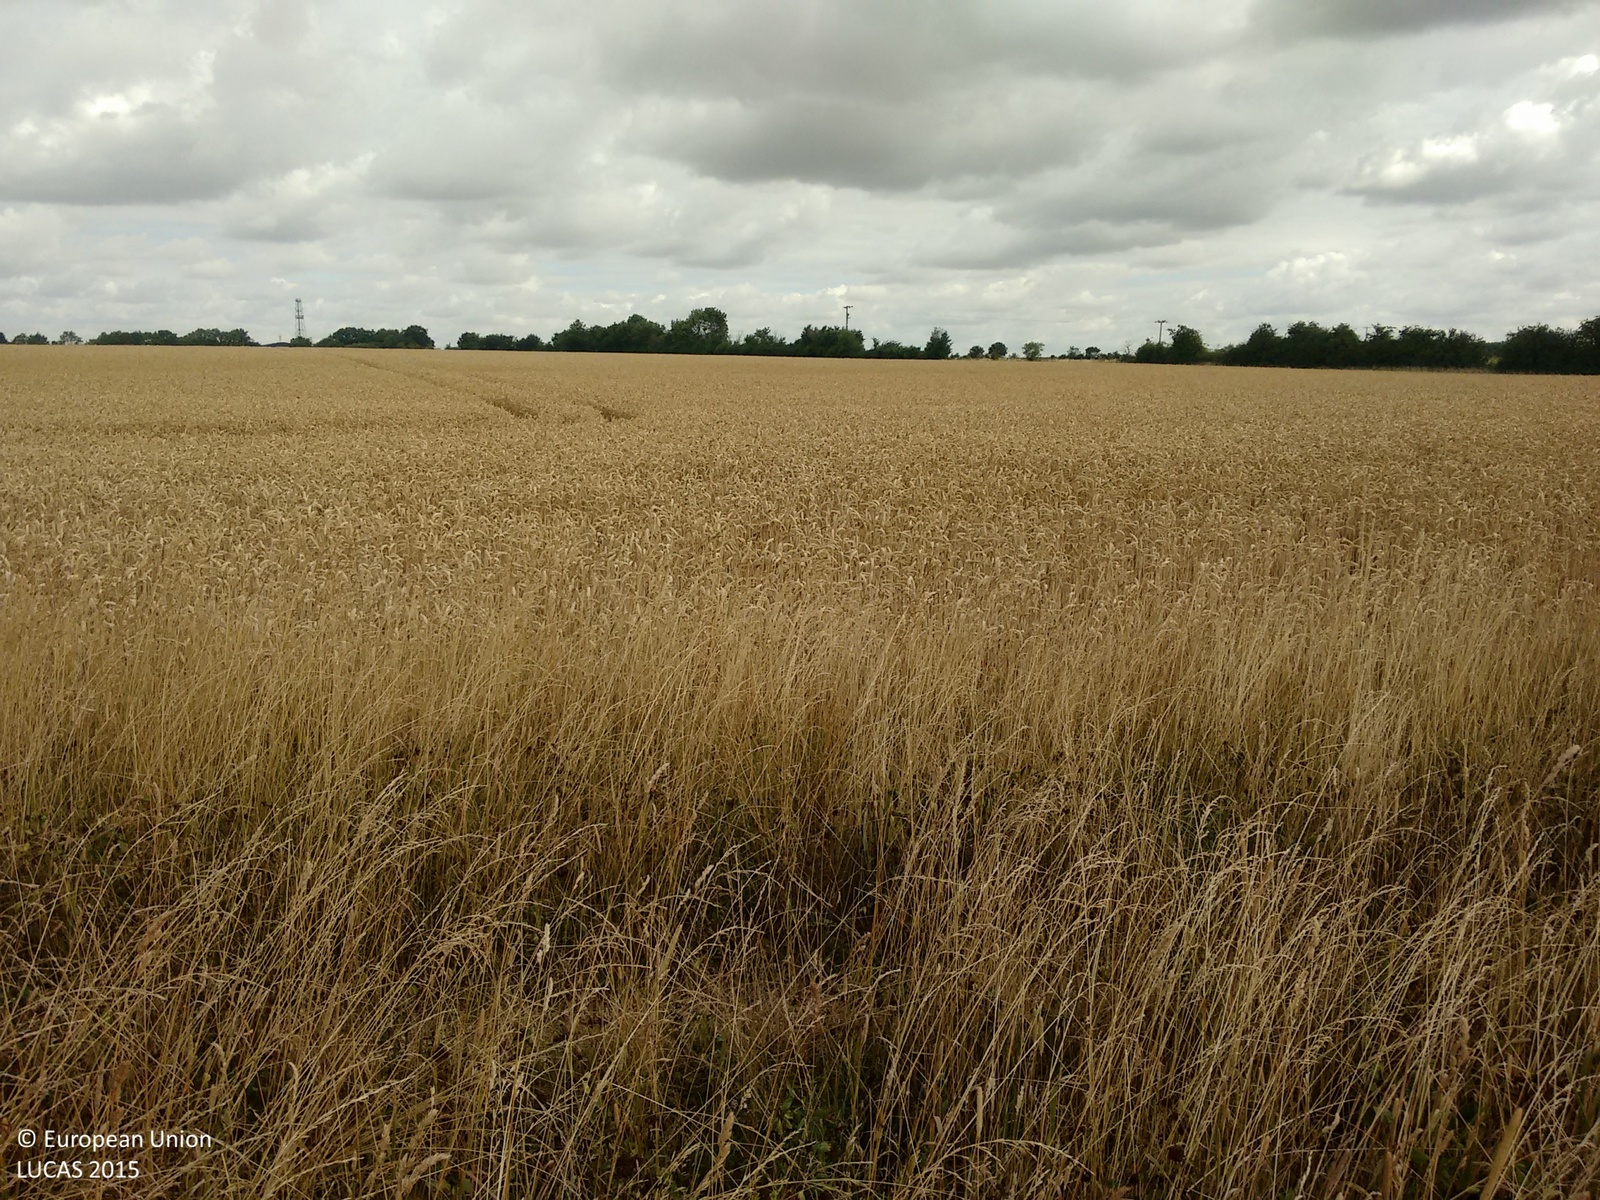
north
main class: Grassland
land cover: Grassland without tree/shrub cover
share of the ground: > 75 %
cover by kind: herbaceous plants 100 %
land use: Agriculture (excluding fallow land and kitchen gardens)
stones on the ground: 10 - 25 %
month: July
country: GB
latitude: 51.8441
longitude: 0.6401
